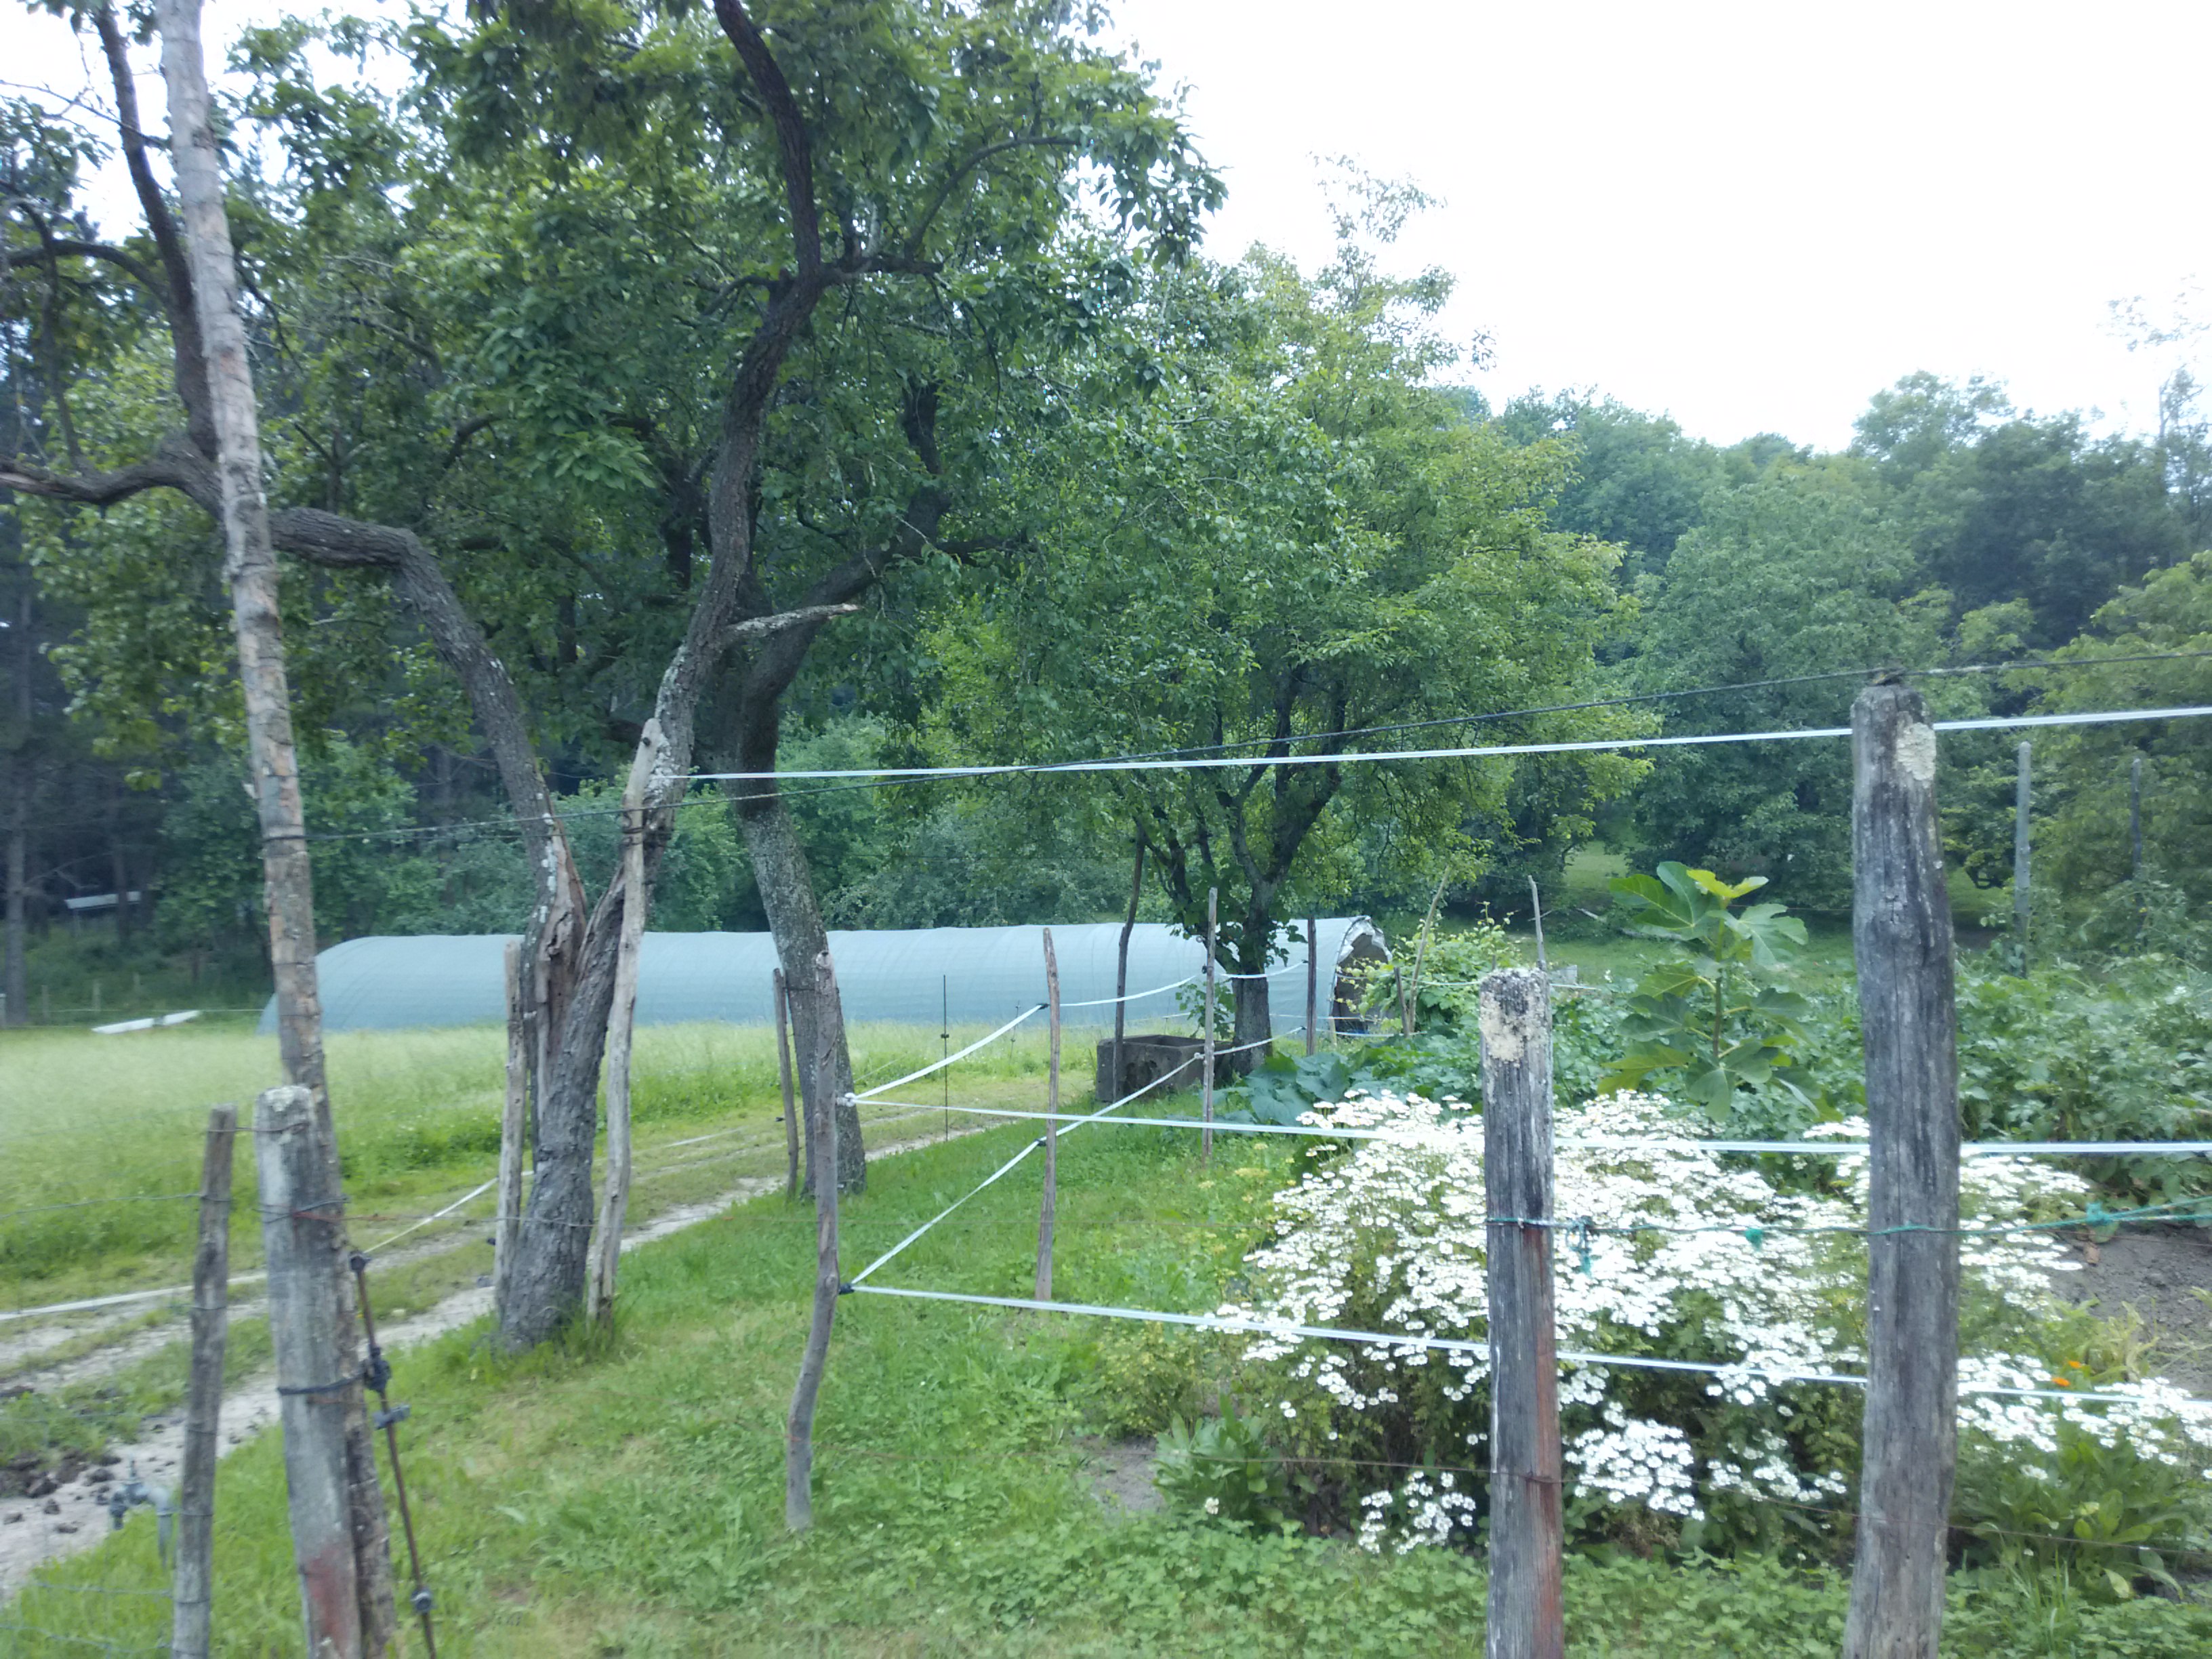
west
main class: Grassland
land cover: Grassland with sparse tree/shrub cover
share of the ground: 25 - 50 %
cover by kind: herbaceous plants 60 %, broadleaved forest trees 5 %, shrubs 5 %
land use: Agriculture (excluding fallow land and kitchen gardens)
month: June
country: ES
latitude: 43.1791
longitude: -2.5896
